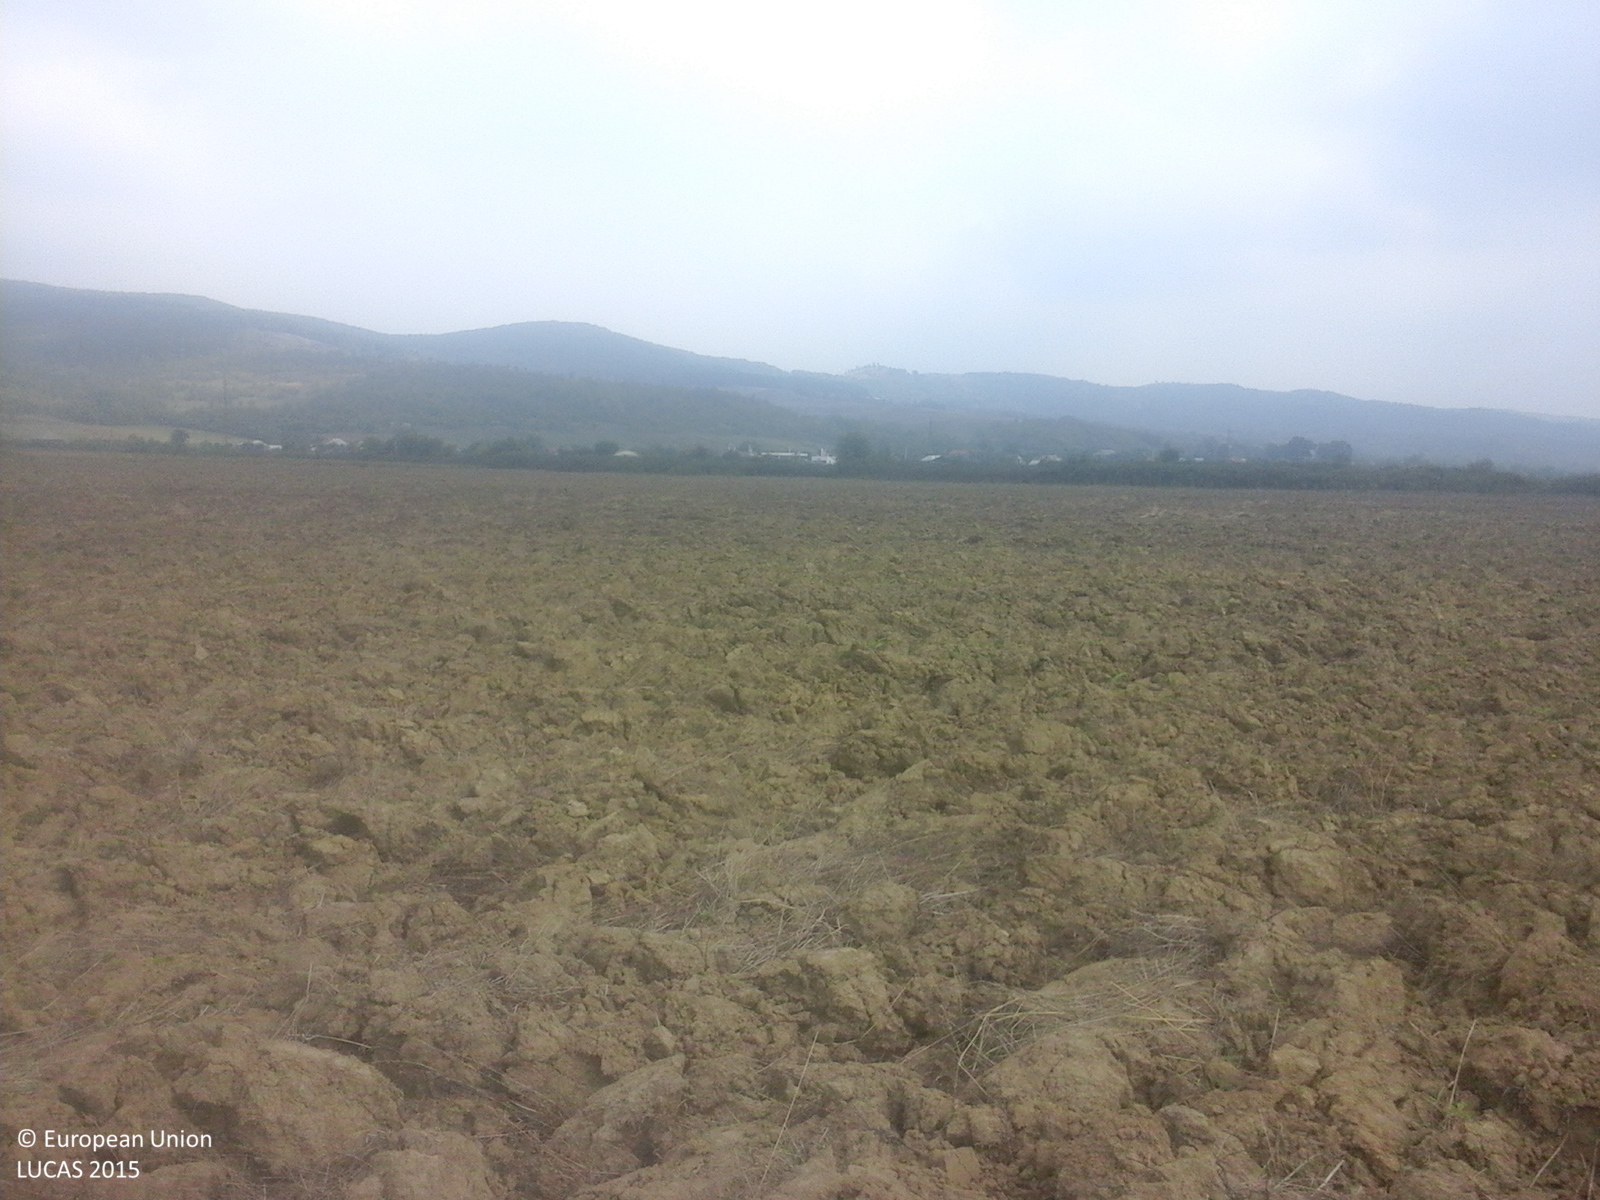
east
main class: Grassland
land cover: Grassland without tree/shrub cover
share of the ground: < 10 %
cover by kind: herbaceous plants 100 %
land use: Agriculture (excluding fallow land and kitchen gardens)
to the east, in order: Grassland without tree/shrub cover
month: September
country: RO
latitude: 44.6804
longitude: 23.4136
